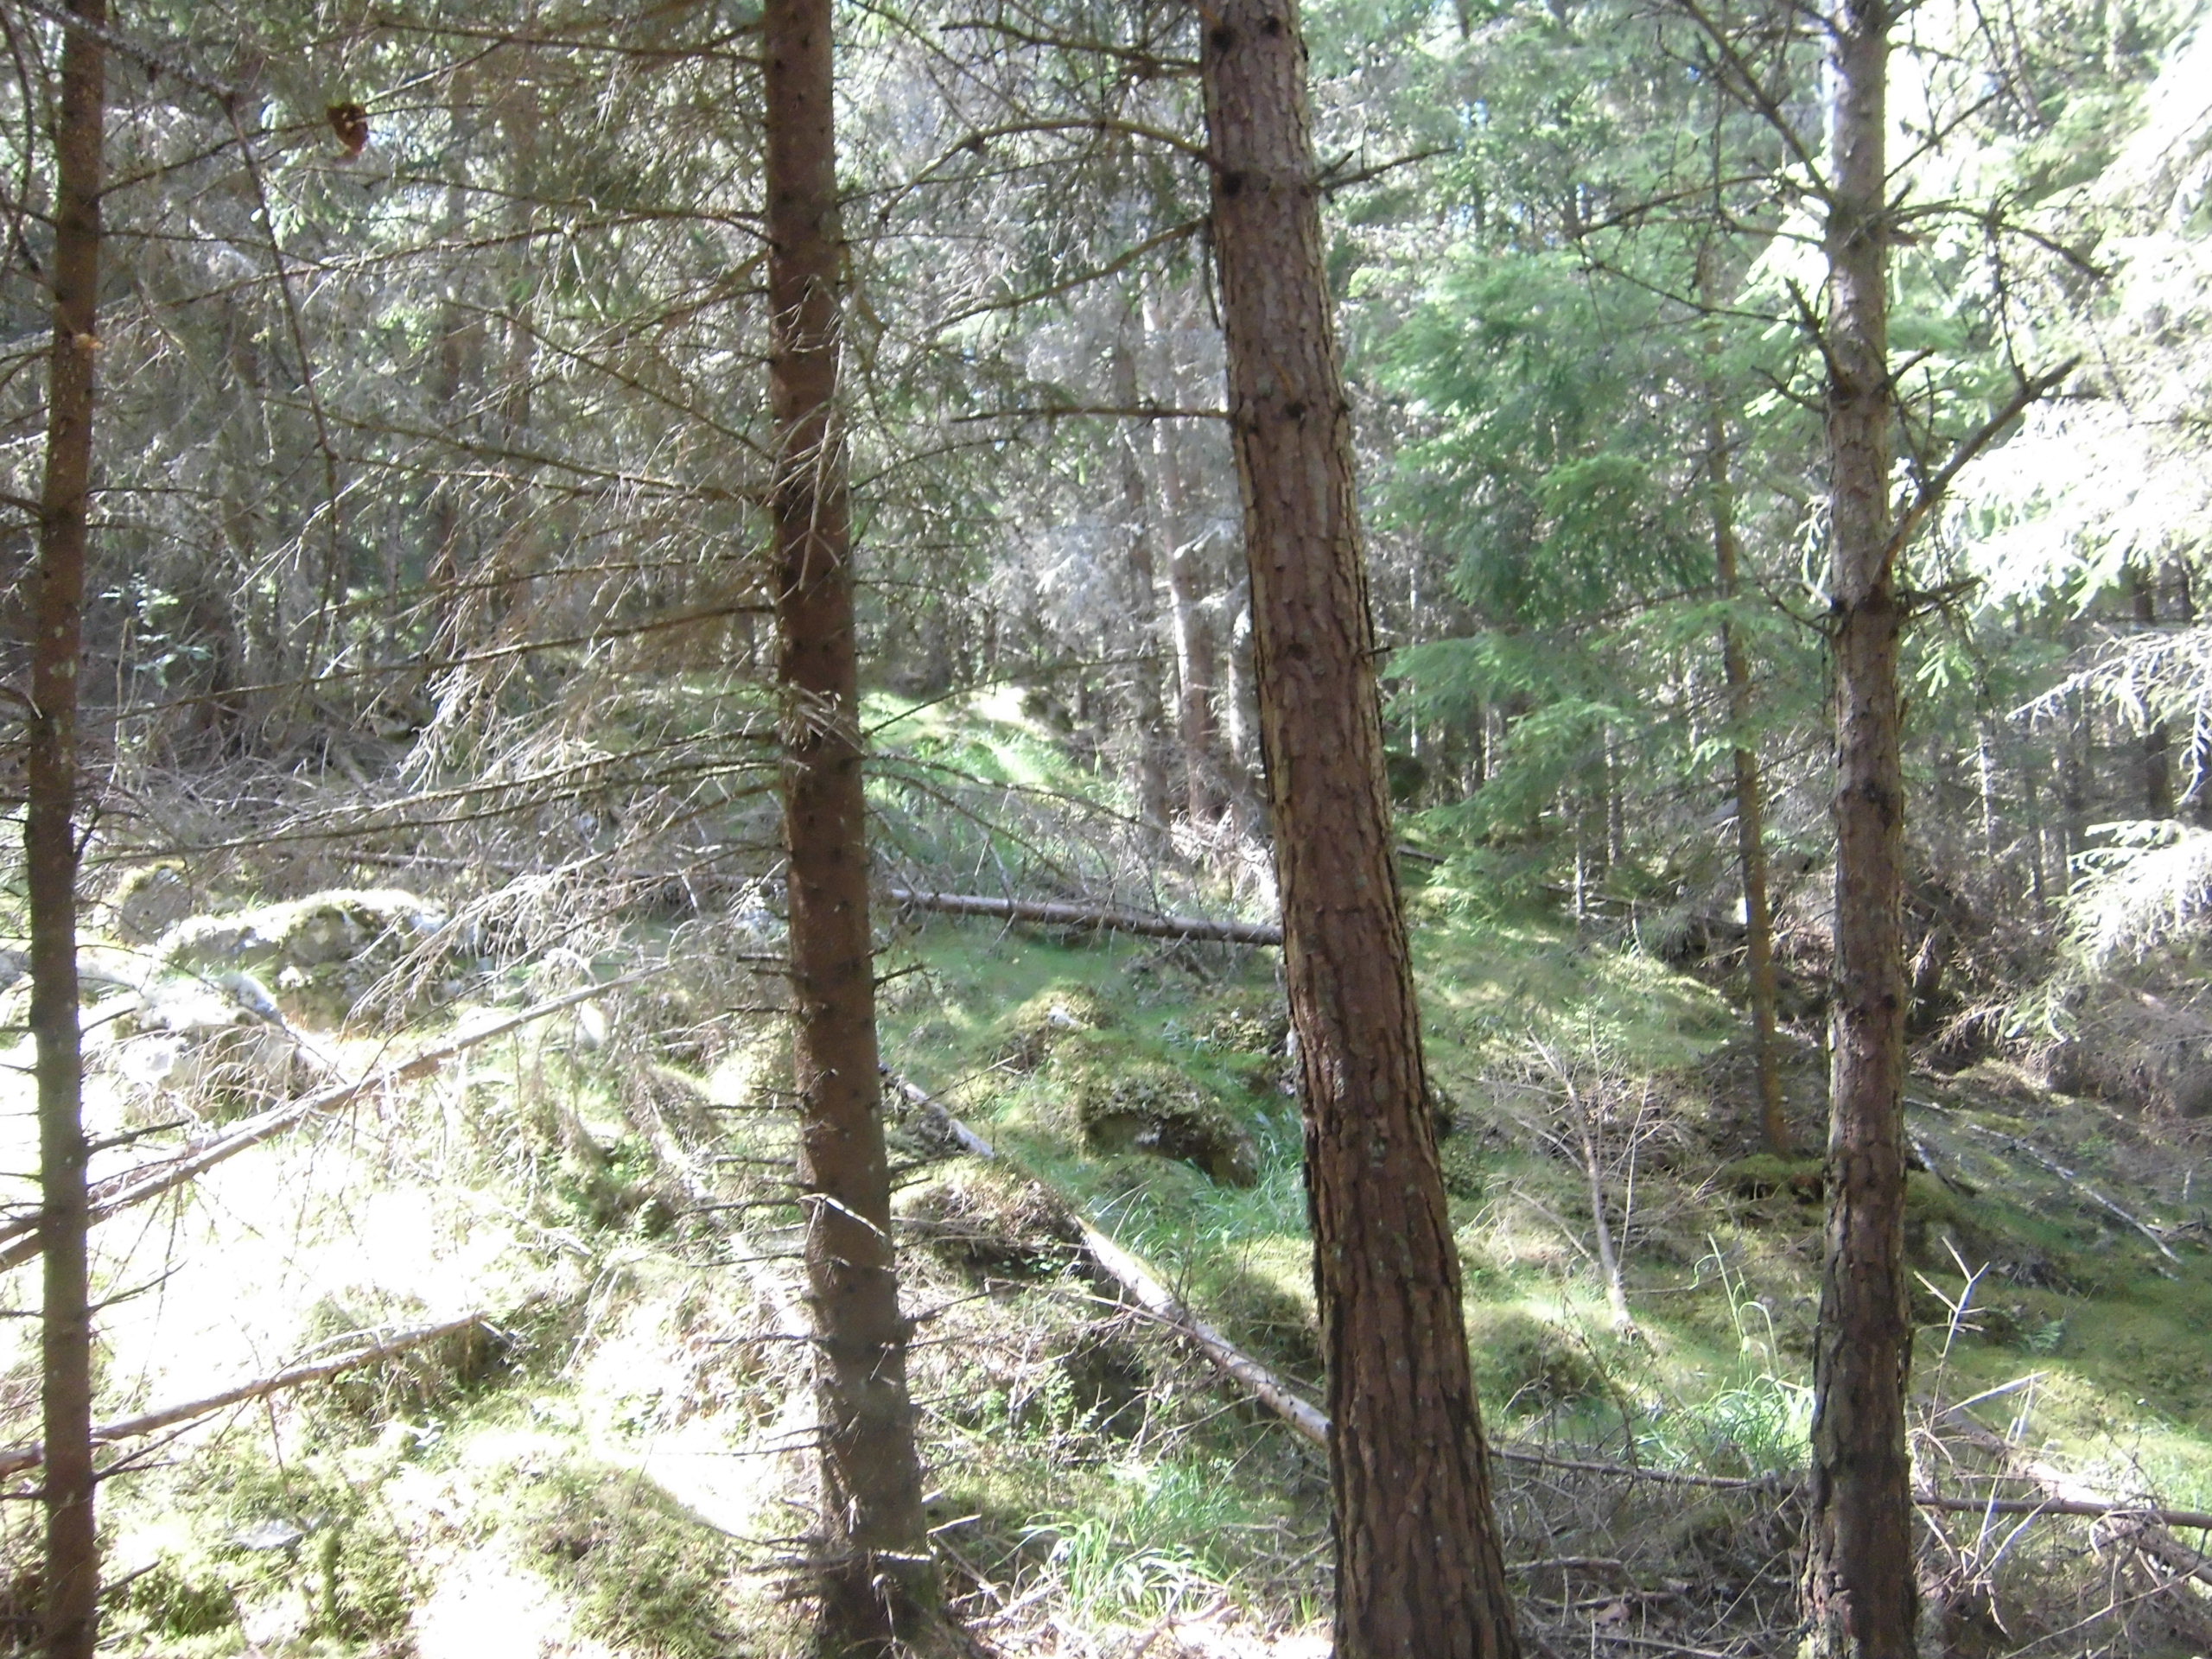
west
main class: Woodland
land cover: Pine dominated coniferous woodland
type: boreal forest
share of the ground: 50 - 75 %
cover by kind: coniferous forest trees 60 %, lichens and mosses 25 %, shrubs 10 %, herbaceous plants 5 %
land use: Forestry
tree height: > 5 m
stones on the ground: < 10 %
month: July
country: SE
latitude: 57.2915
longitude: 15.1571
